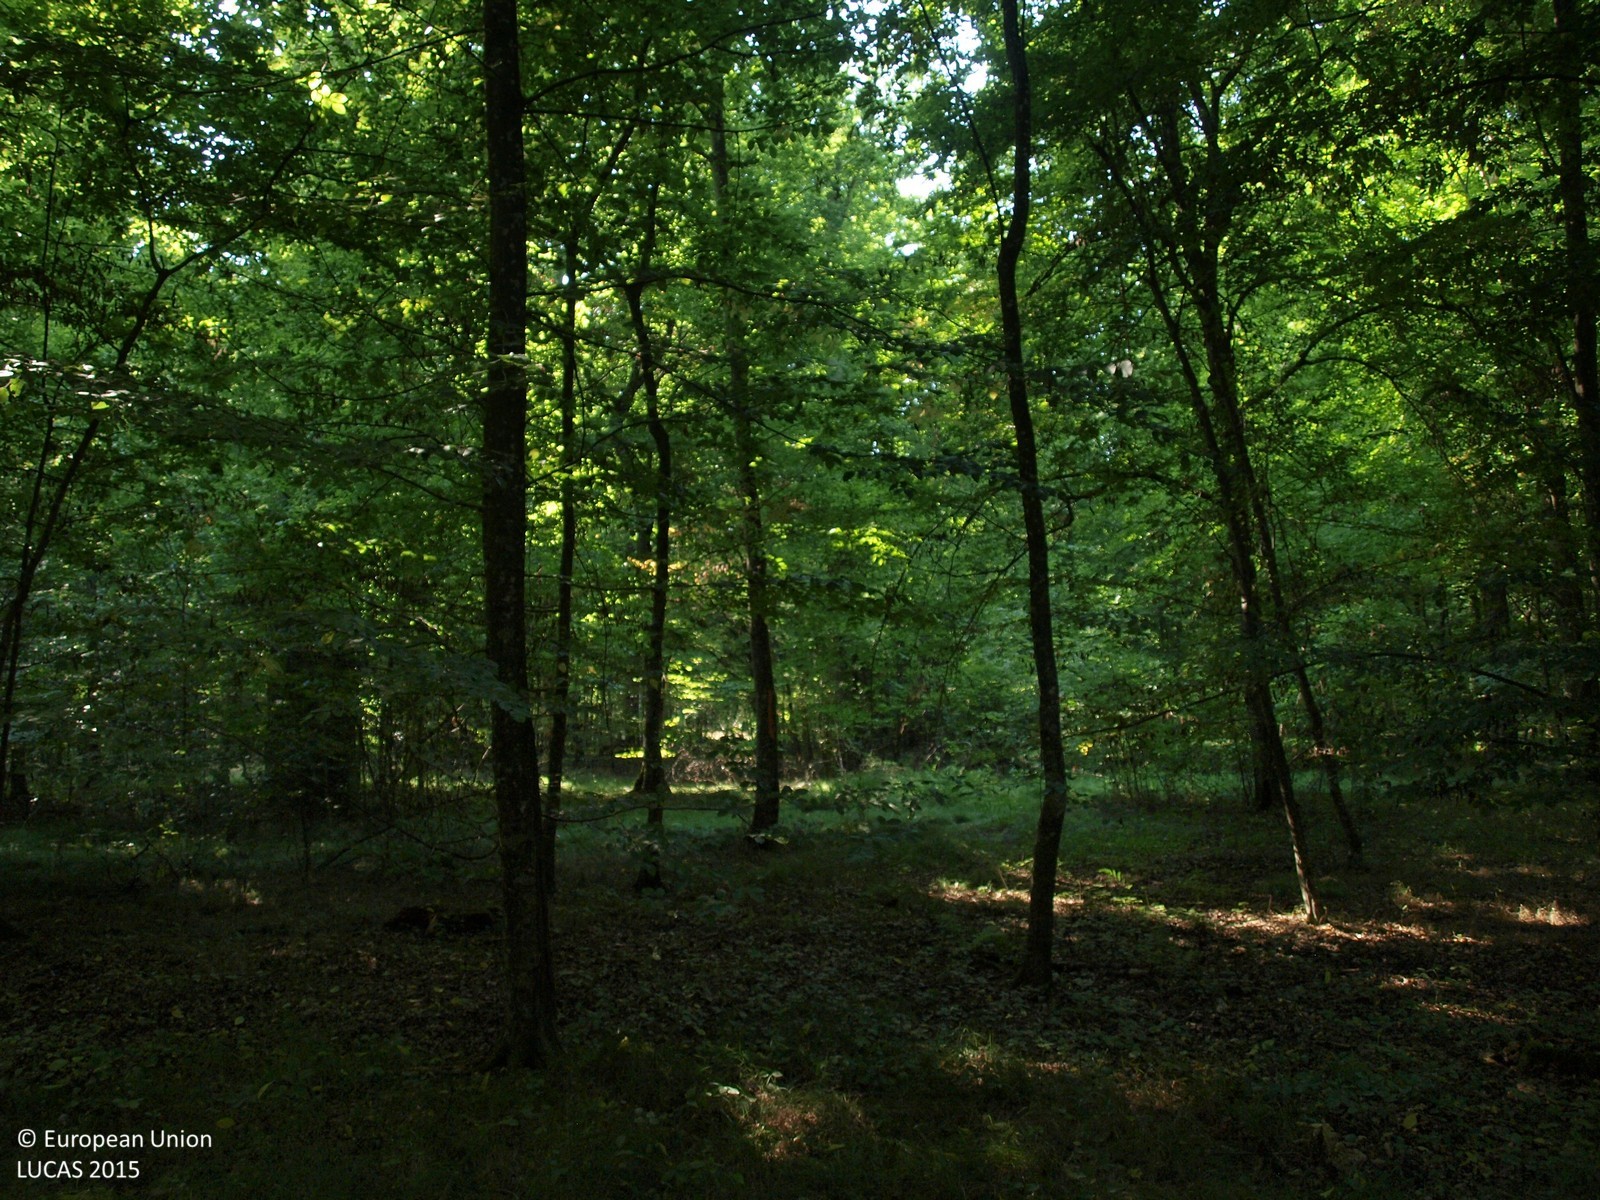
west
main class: Woodland
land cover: Broadleaved woodland
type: mesophytic deciduous forest
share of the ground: > 75 %
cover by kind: broadleaved forest trees 100 %
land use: Forestry
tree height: > 5 m
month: August
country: HR
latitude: 45.8904
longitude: 16.6624
